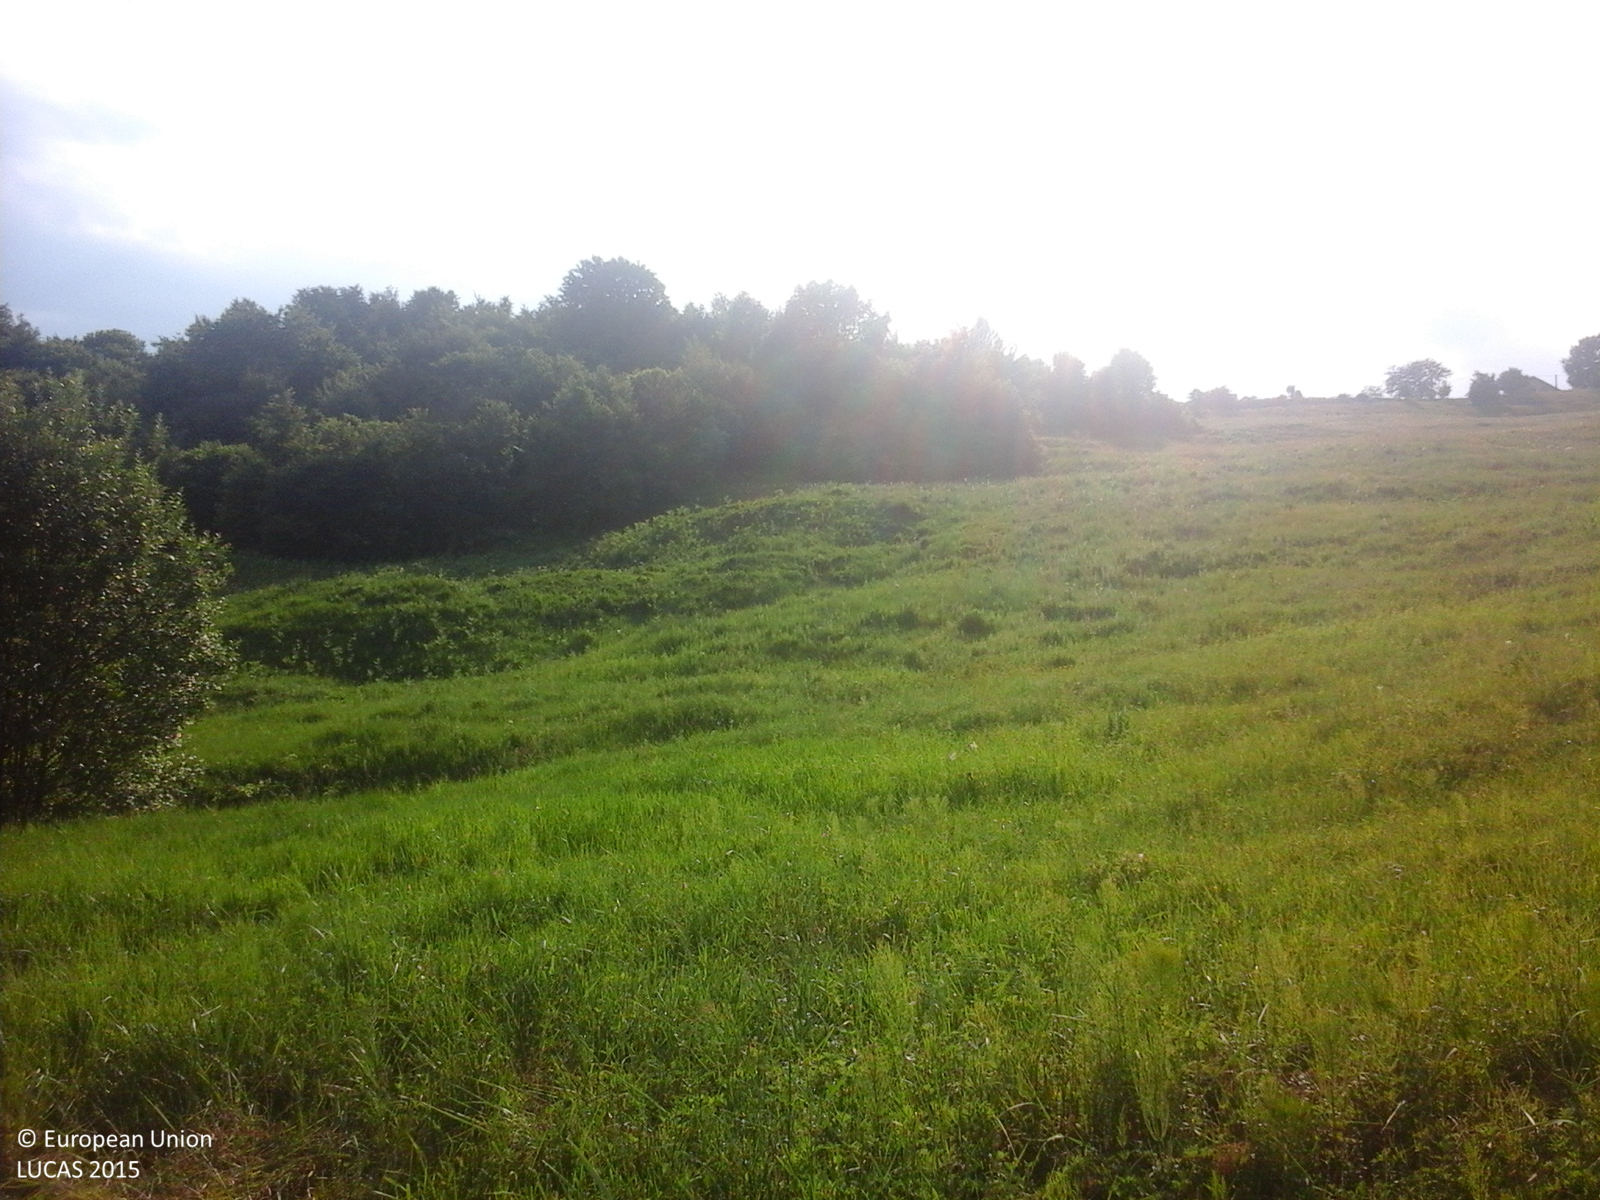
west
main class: Grassland
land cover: Grassland without tree/shrub cover
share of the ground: > 75 %
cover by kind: herbaceous plants 100 %
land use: Agriculture (excluding fallow land and kitchen gardens)
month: June
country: RO
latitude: 46.6996
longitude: 26.5771
